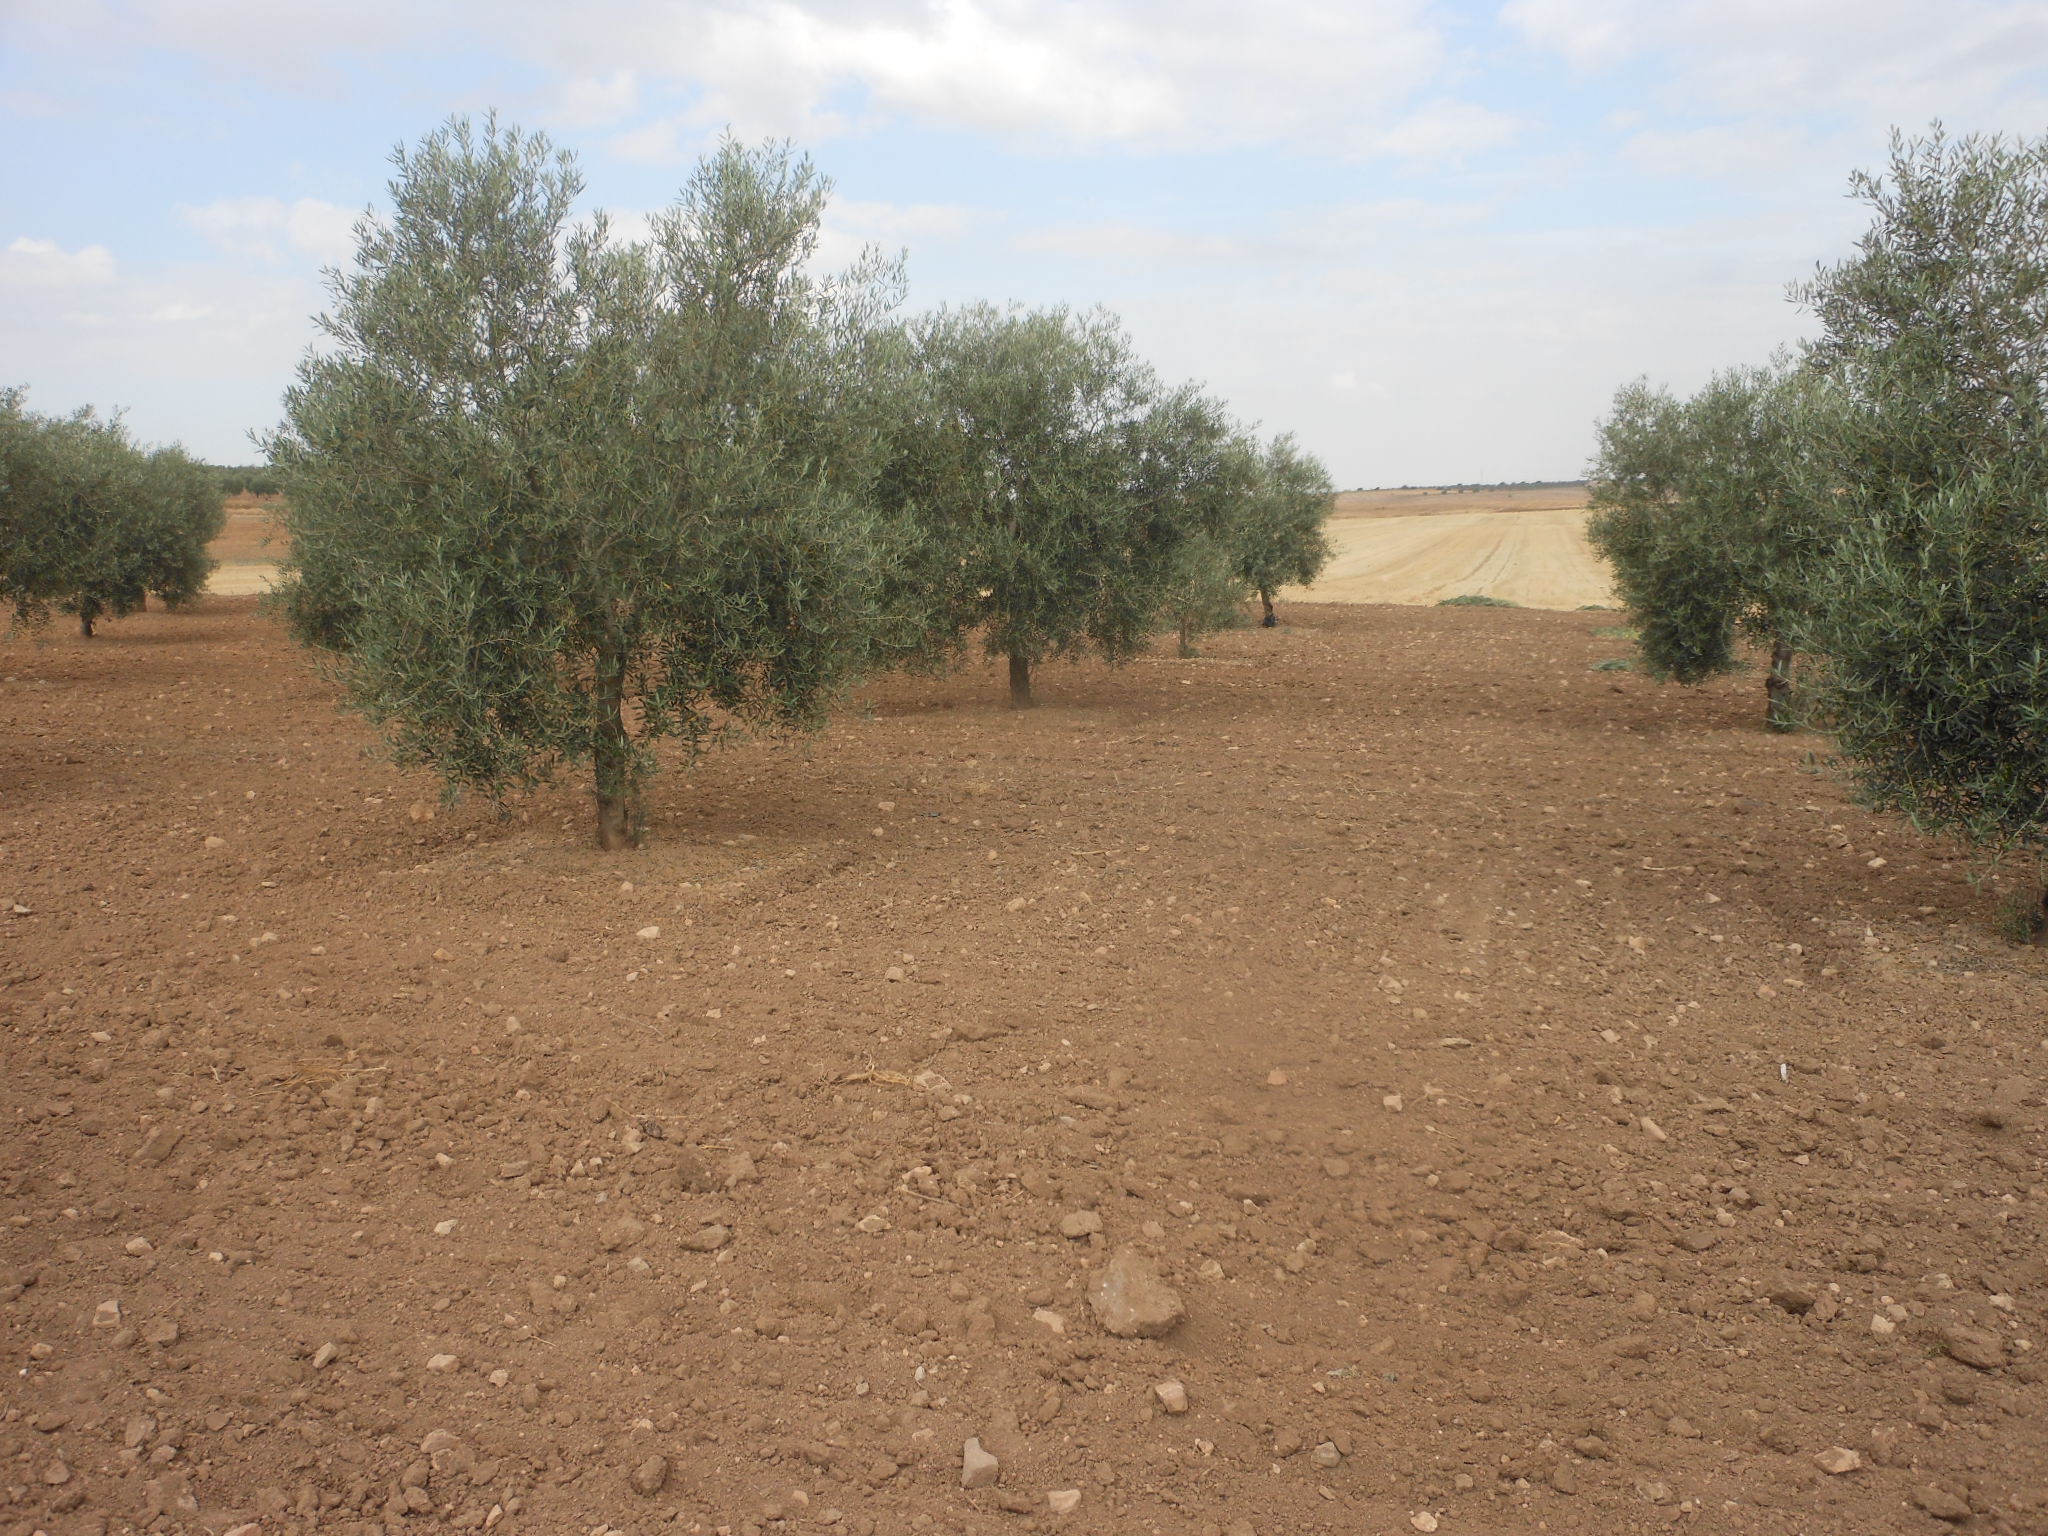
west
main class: Cropland
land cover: Olive groves
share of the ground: 25 - 50 %
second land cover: Other bare soil
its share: > 75 %
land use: Agriculture (excluding fallow land and kitchen gardens)
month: June
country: ES
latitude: 37.3511
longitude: -5.0573
